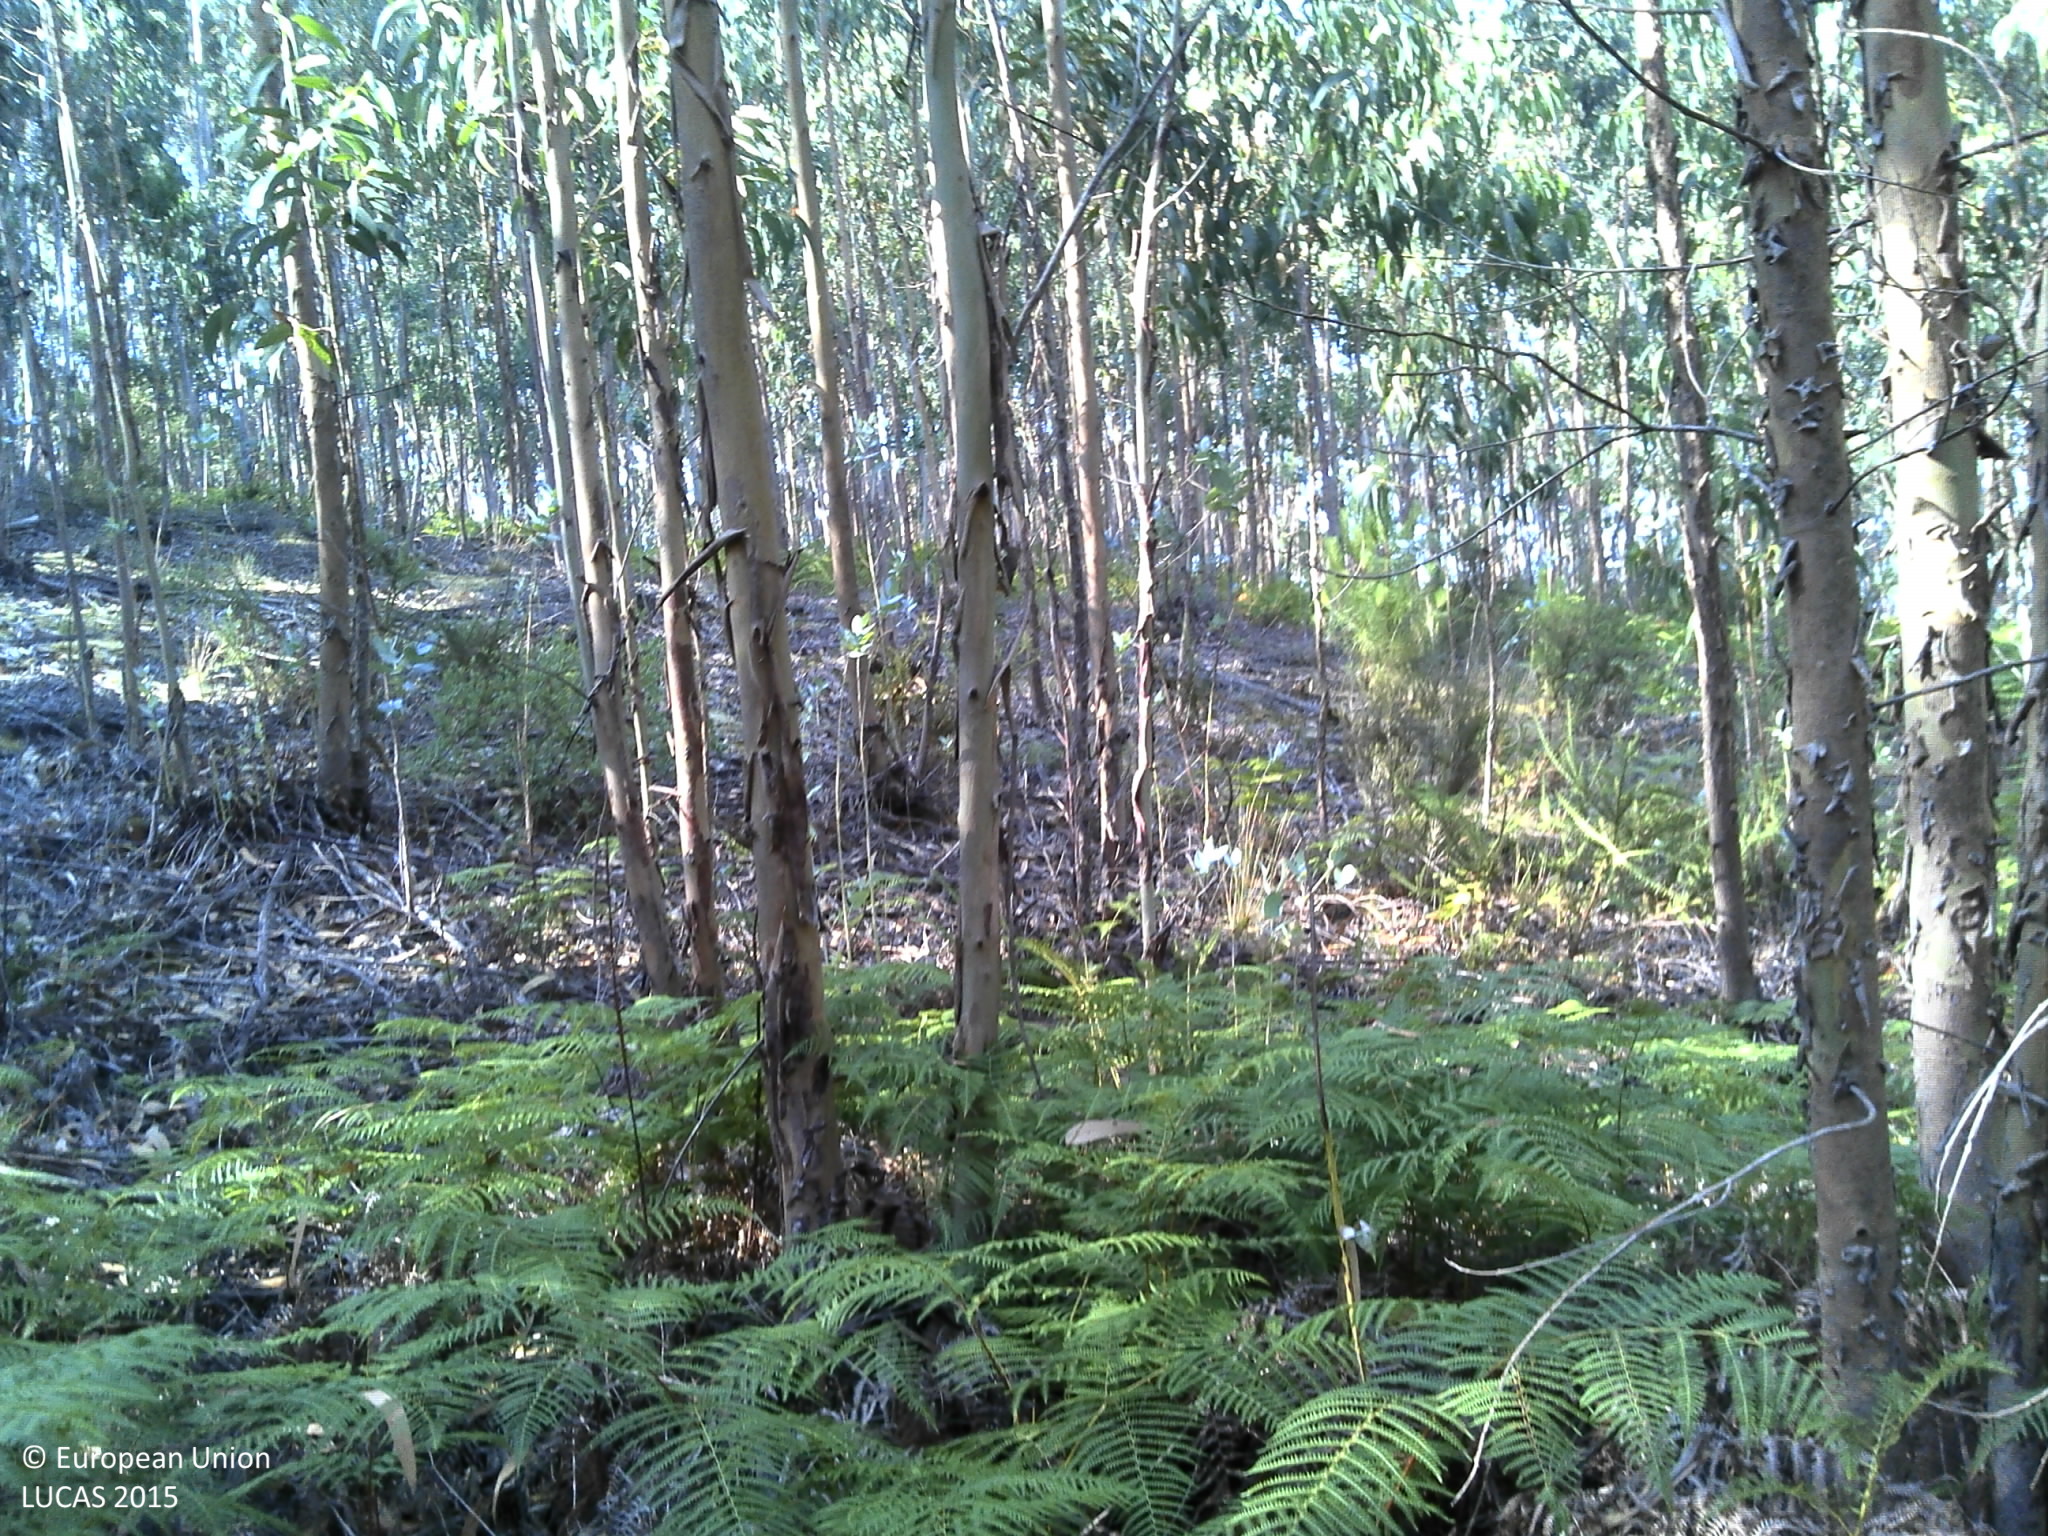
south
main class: Woodland
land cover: Broadleaved woodland
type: exotic forest
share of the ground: > 75 %
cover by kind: broadleaved forest trees 75 %, unconsolidated bare surface 20 %, shrubs 5 %
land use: Forestry
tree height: > 5 m
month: June
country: PT
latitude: 39.1188
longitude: -9.2516
